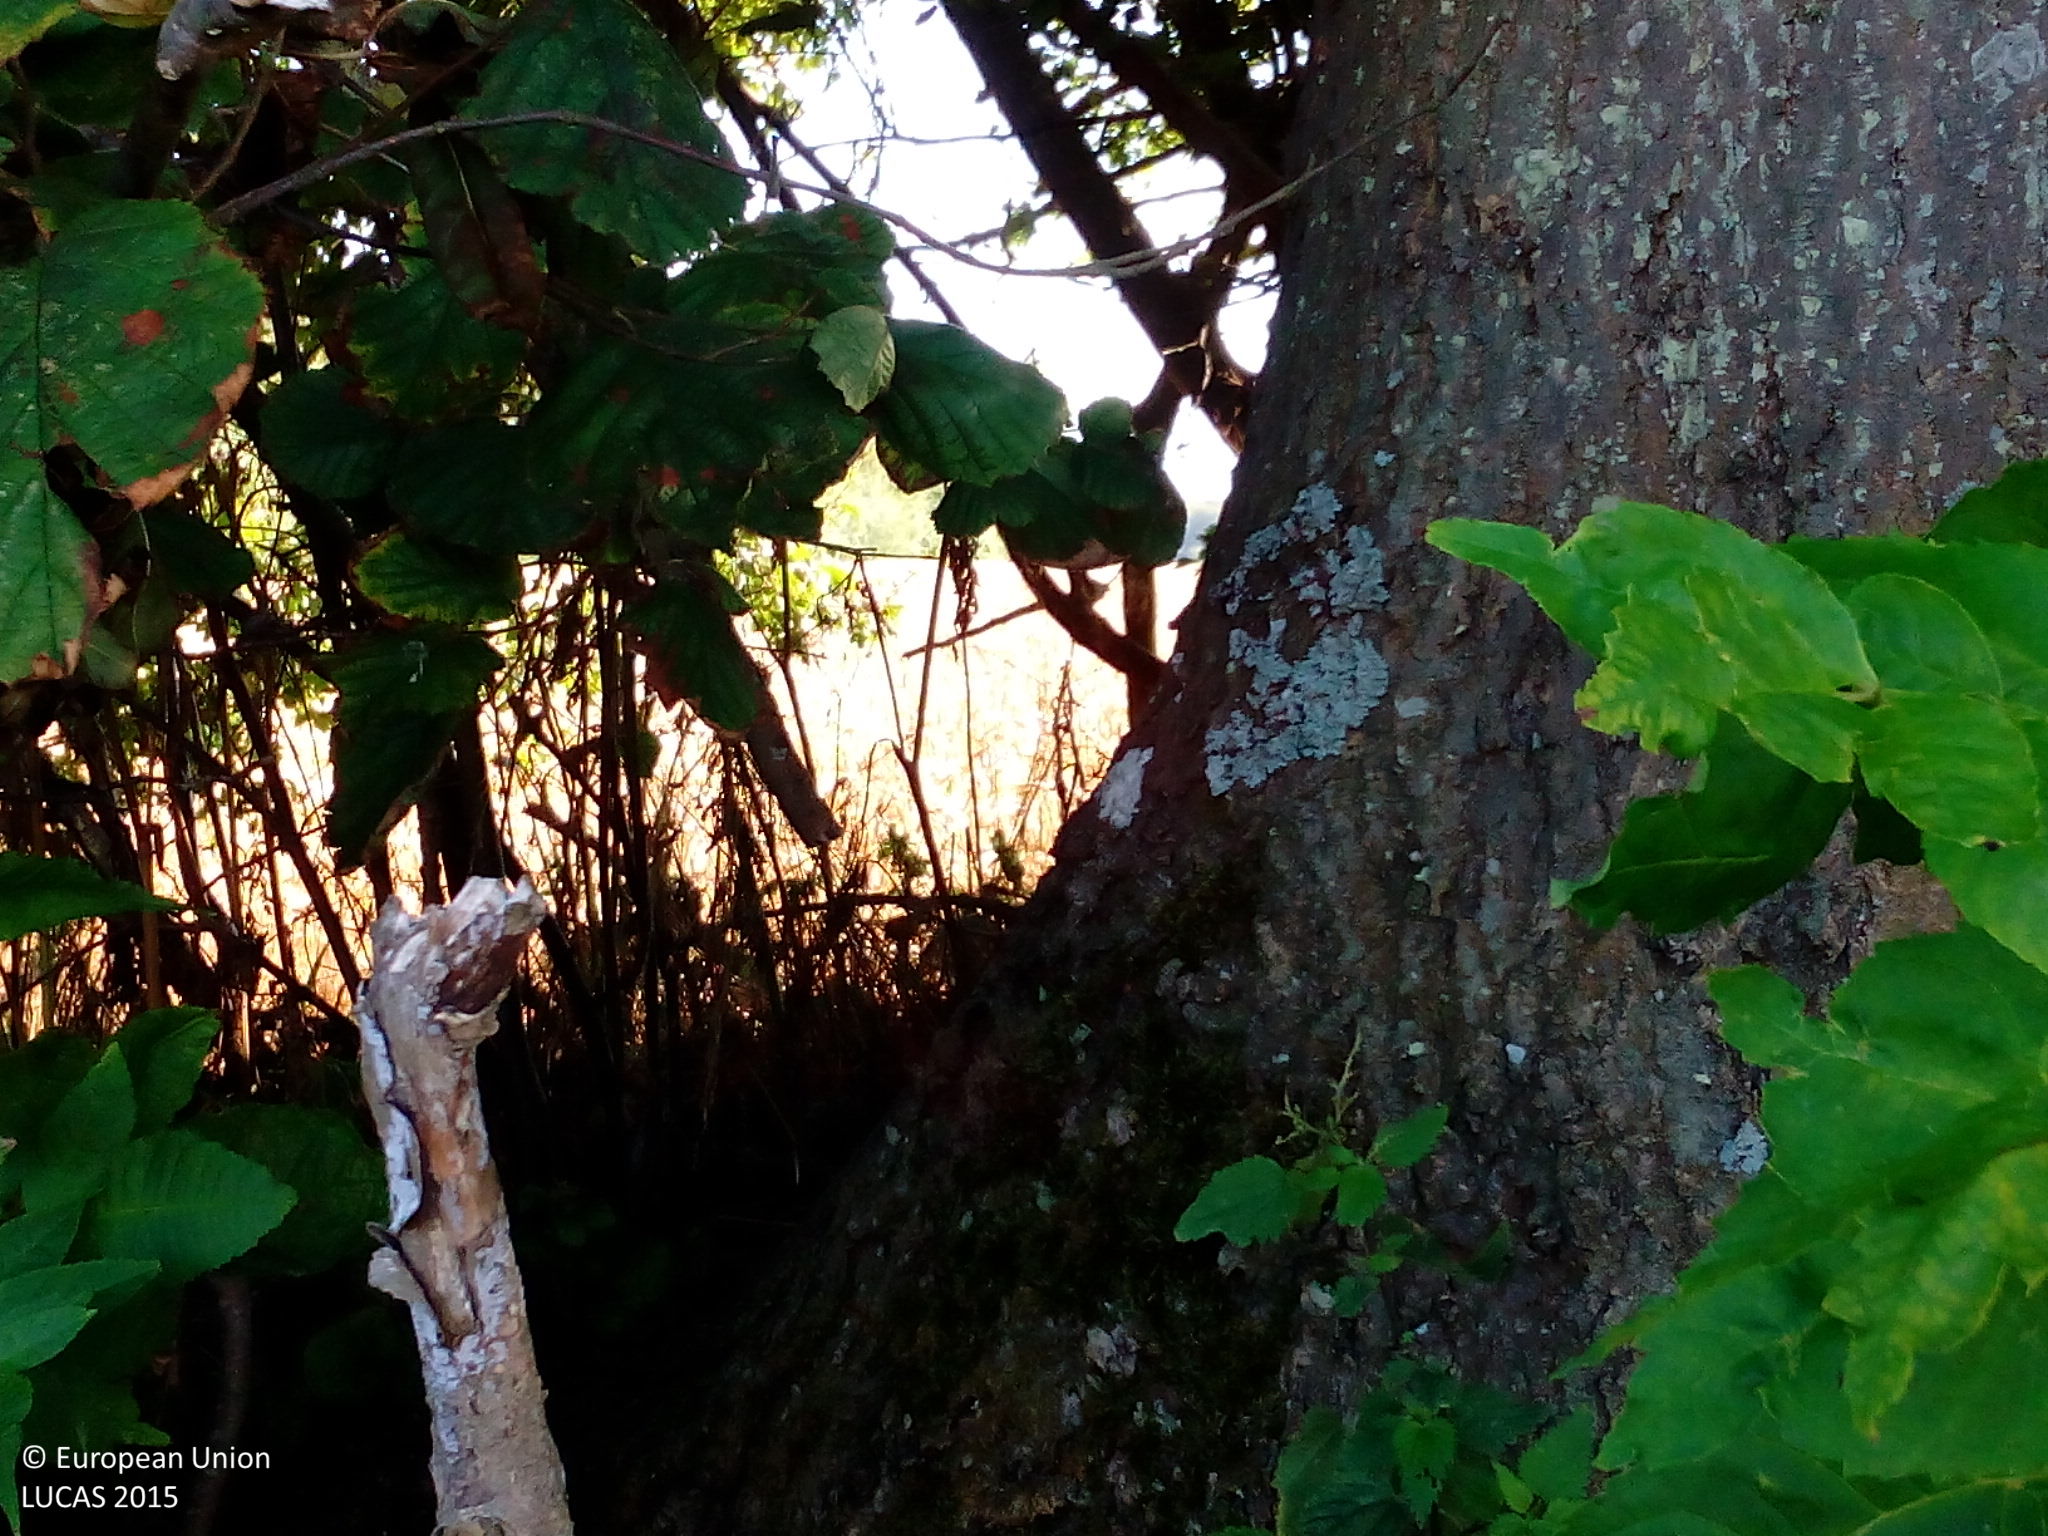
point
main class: Cropland
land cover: Common wheat
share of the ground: > 75 %
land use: Agriculture (excluding fallow land and kitchen gardens)
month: August
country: DK
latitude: 55.2510
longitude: 12.2480
